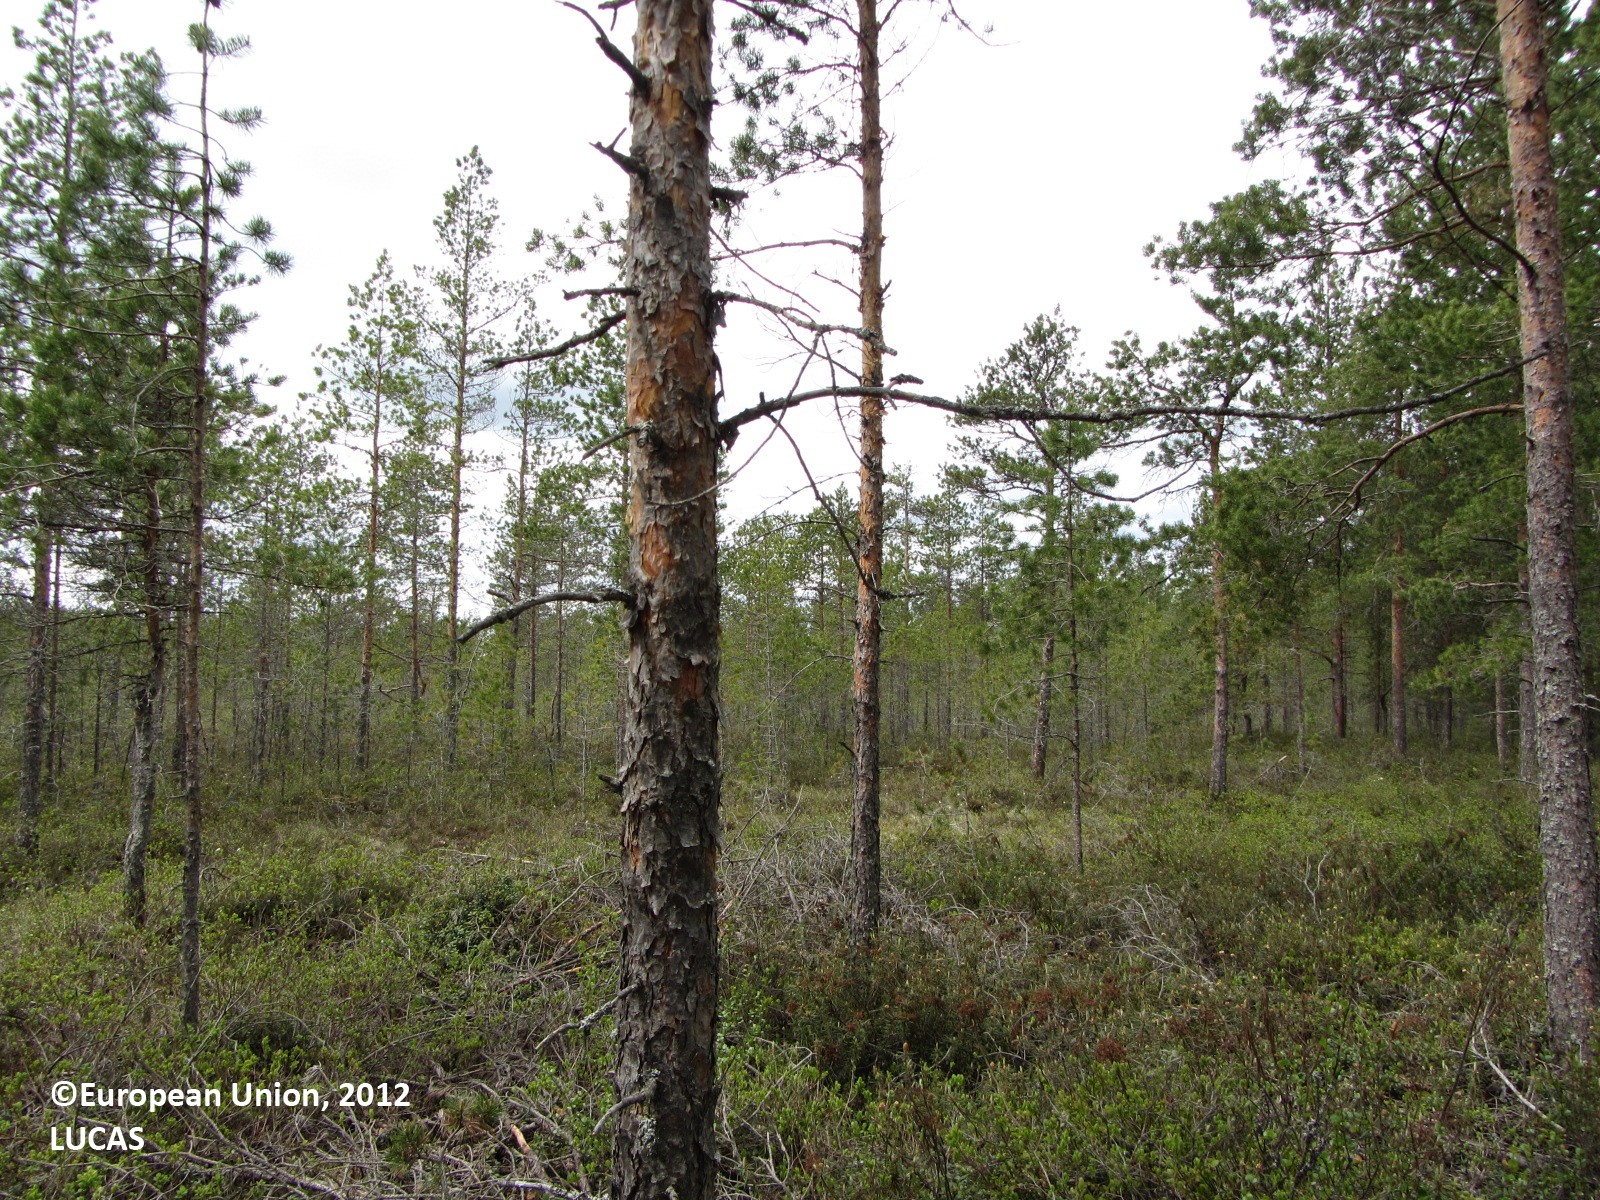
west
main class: Woodland
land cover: Pine dominated coniferous woodland
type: boreal forest
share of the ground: 50 - 75 %
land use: Forestry
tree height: > 5 m
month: June
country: FI
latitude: 63.8027
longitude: 24.6780
